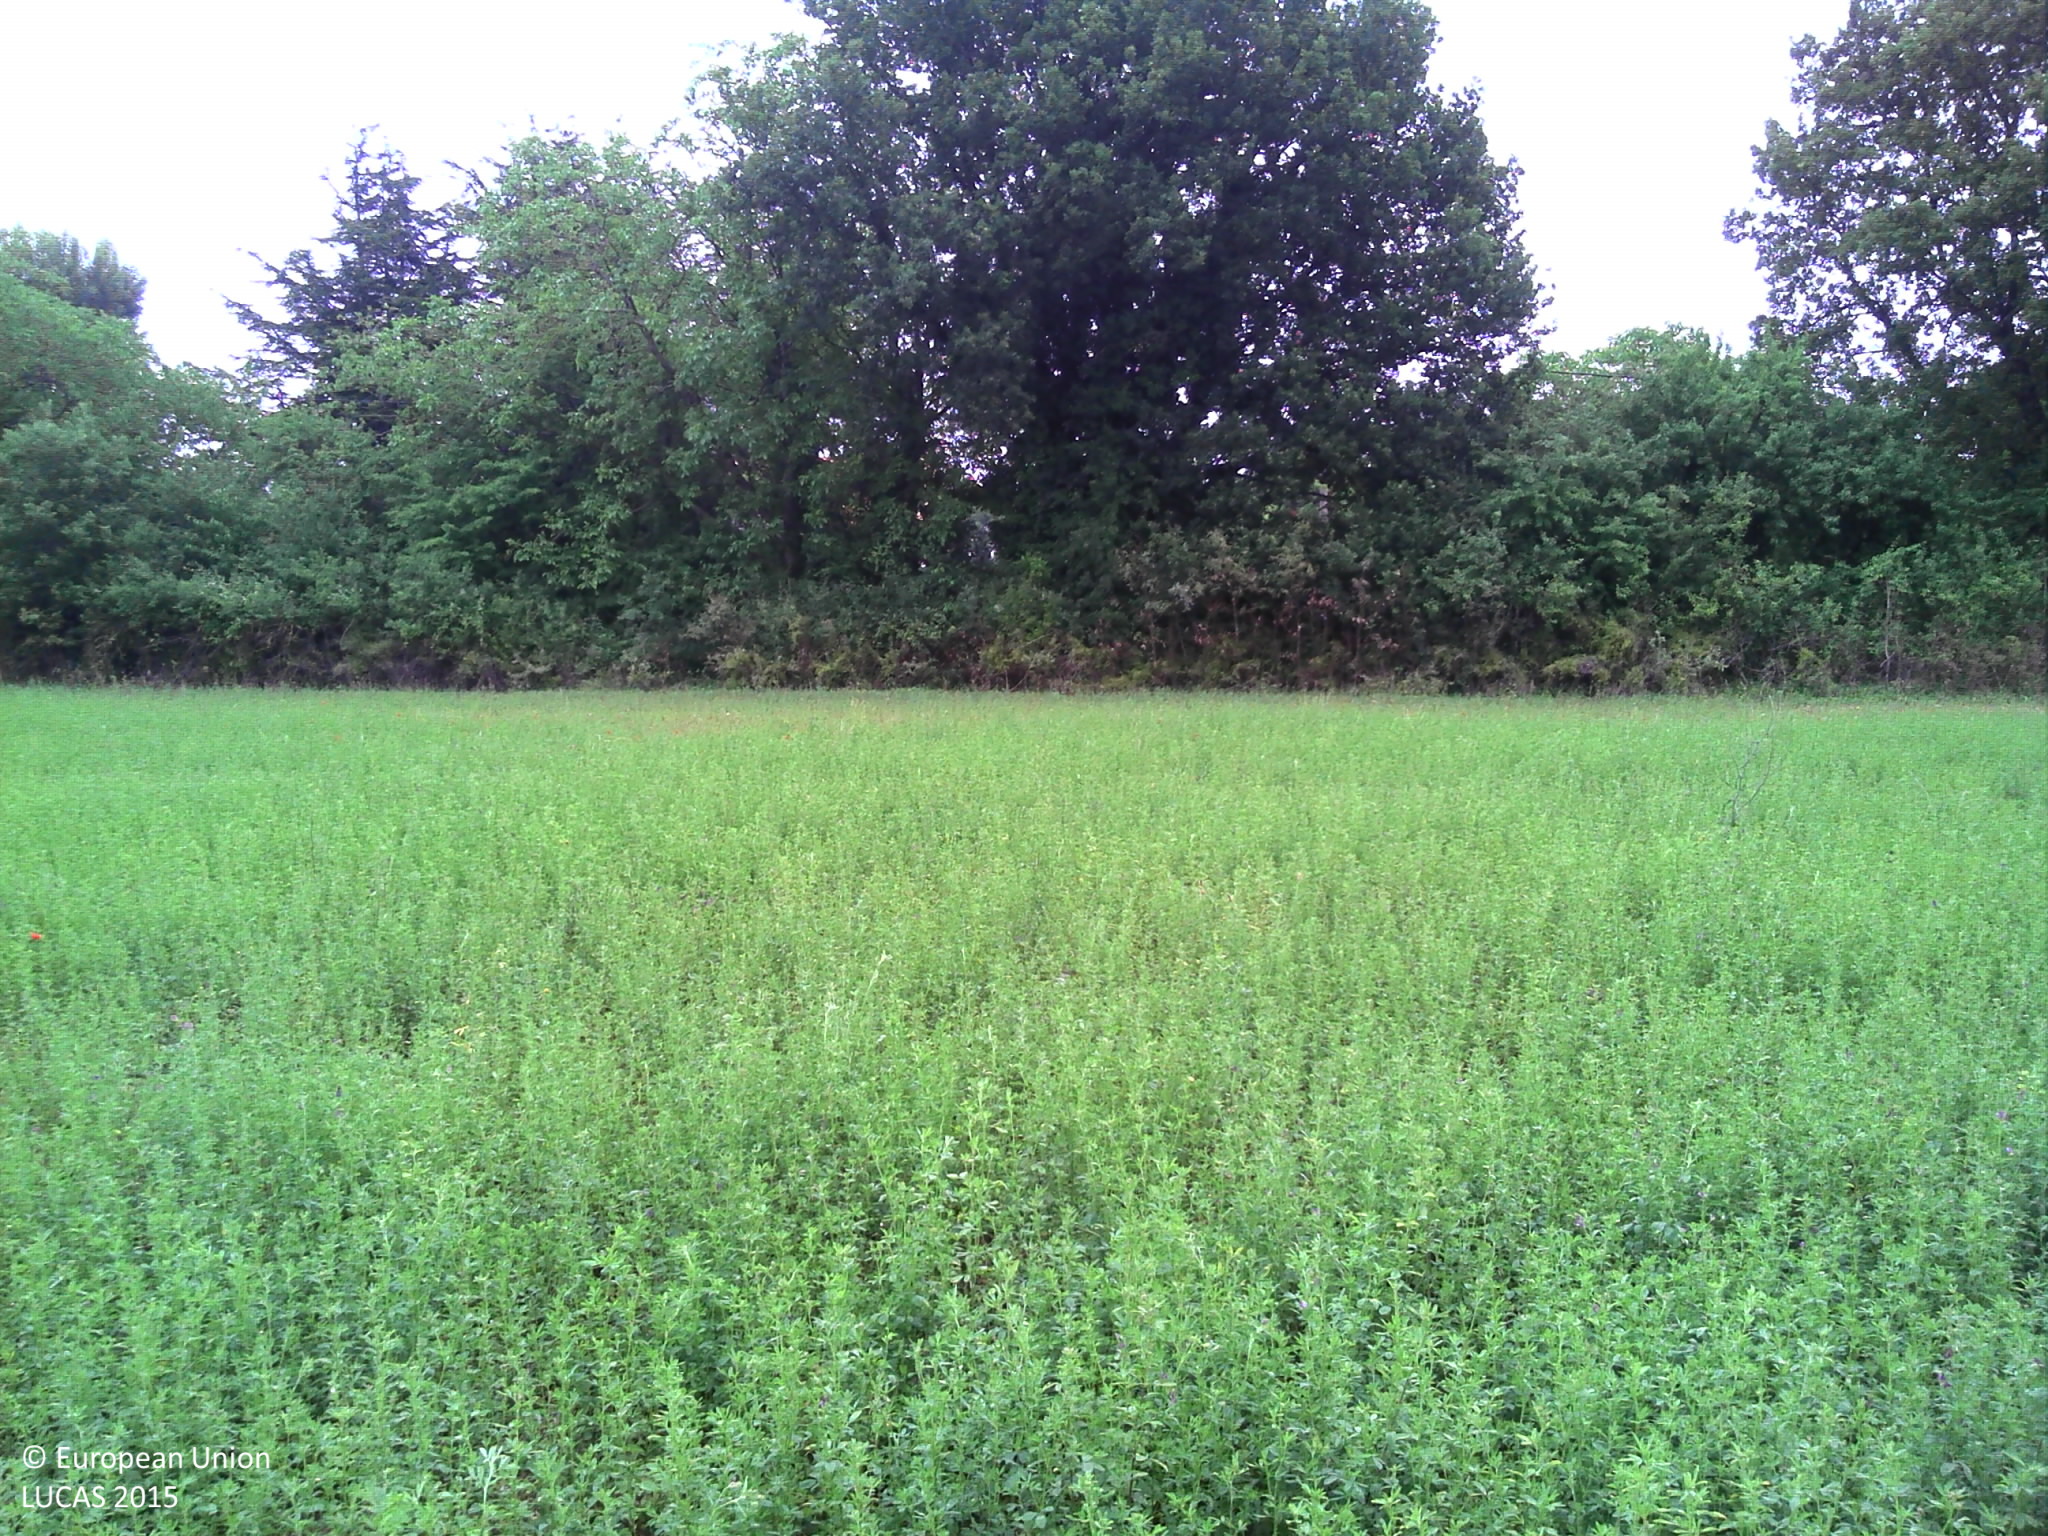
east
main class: Cropland
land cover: Lucerne
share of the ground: > 75 %
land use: Agriculture (excluding fallow land and kitchen gardens)
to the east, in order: Lucerne; Abandoned hedges; Grass margins; Paved roads, cycling and walking lanes; Grass margins; Electric lines; Artificial constructions in urban areas; Maize; Abandoned hedges; Tracks; Abandoned hedges; Maize; Electric lines; Maize
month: June
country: FR
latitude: 46.5596
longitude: 0.4727
